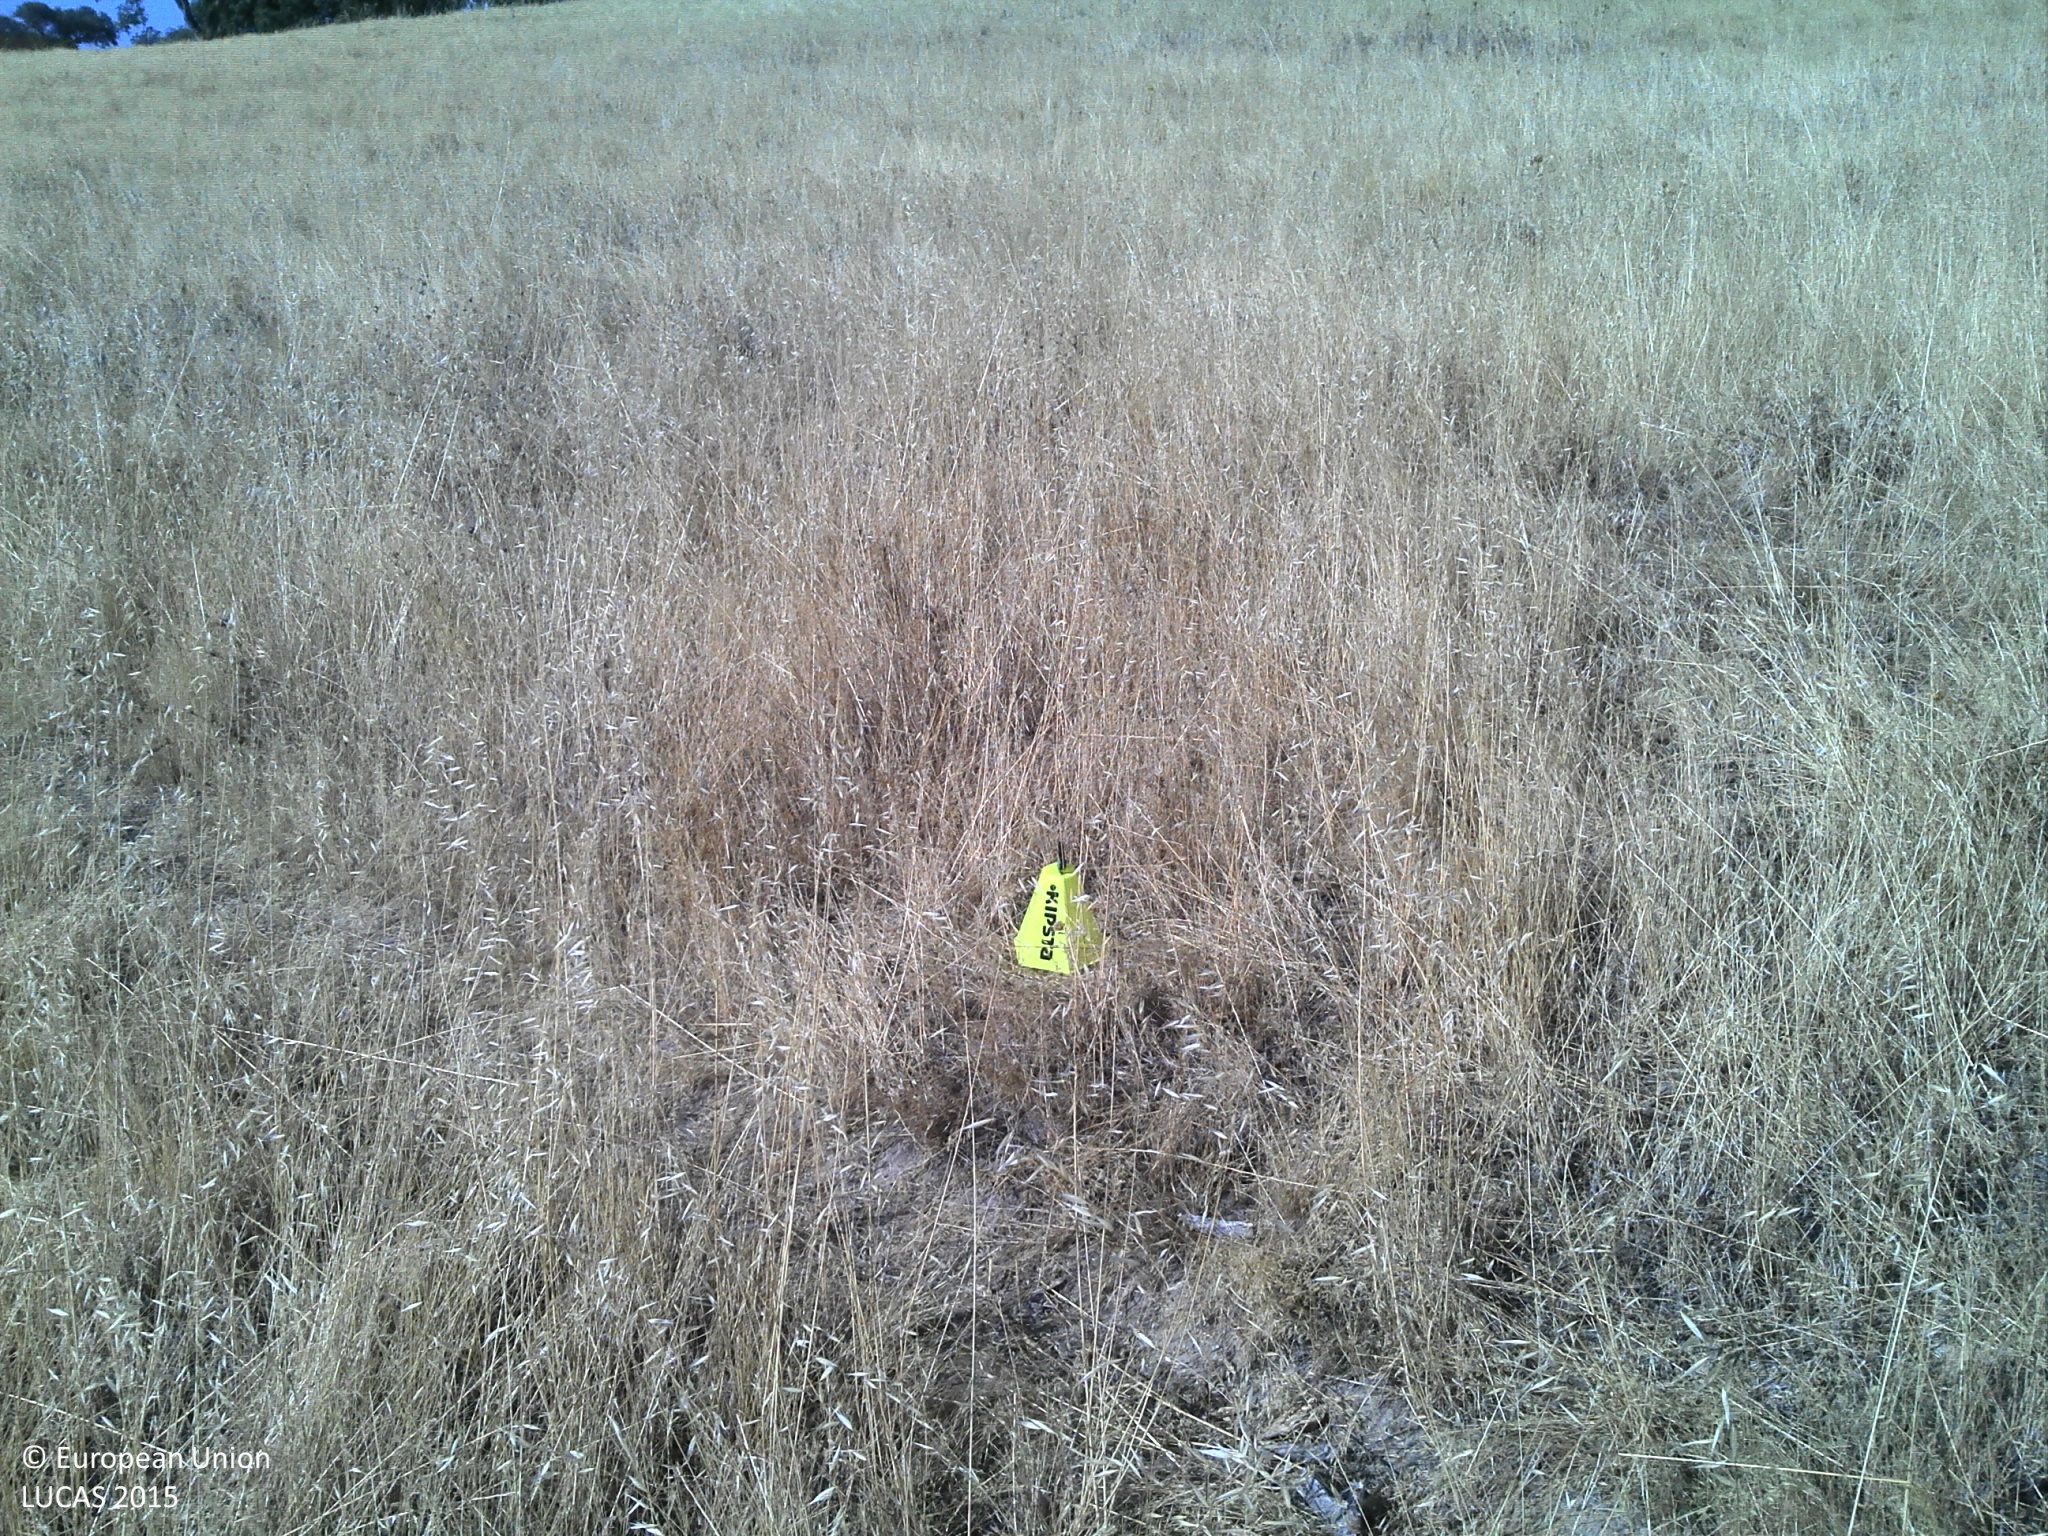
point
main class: Grassland
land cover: Grassland without tree/shrub cover
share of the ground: 50 - 75 %
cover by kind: herbaceous plants 75 %, unconsolidated bare surface 25 %
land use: Agriculture (excluding fallow land and kitchen gardens)
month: July
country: PT
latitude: 38.6443
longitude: -7.2951
